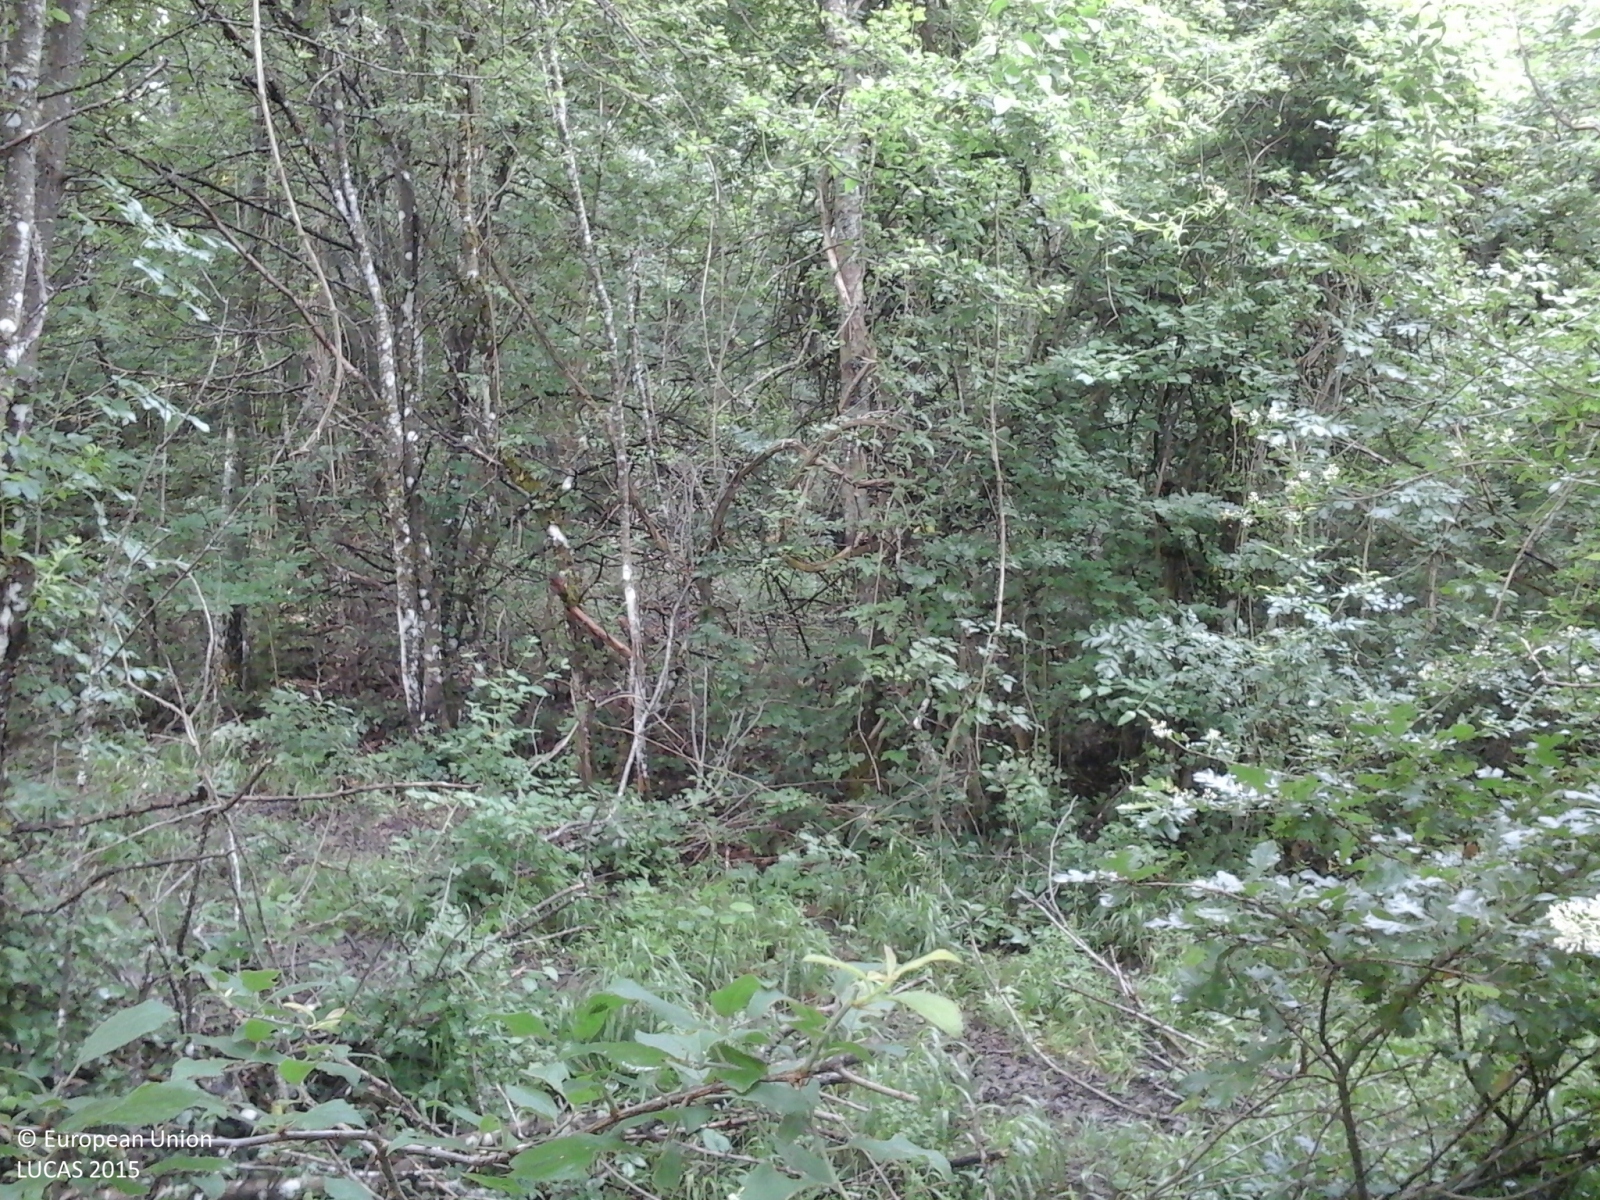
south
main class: Woodland
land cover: Broadleaved woodland
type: thermophilous deciduous forest
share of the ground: > 75 %
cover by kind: broadleaved forest trees 100 %
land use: Forestry
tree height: > 5 m
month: June
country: IT
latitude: 44.6562
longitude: 9.5596
